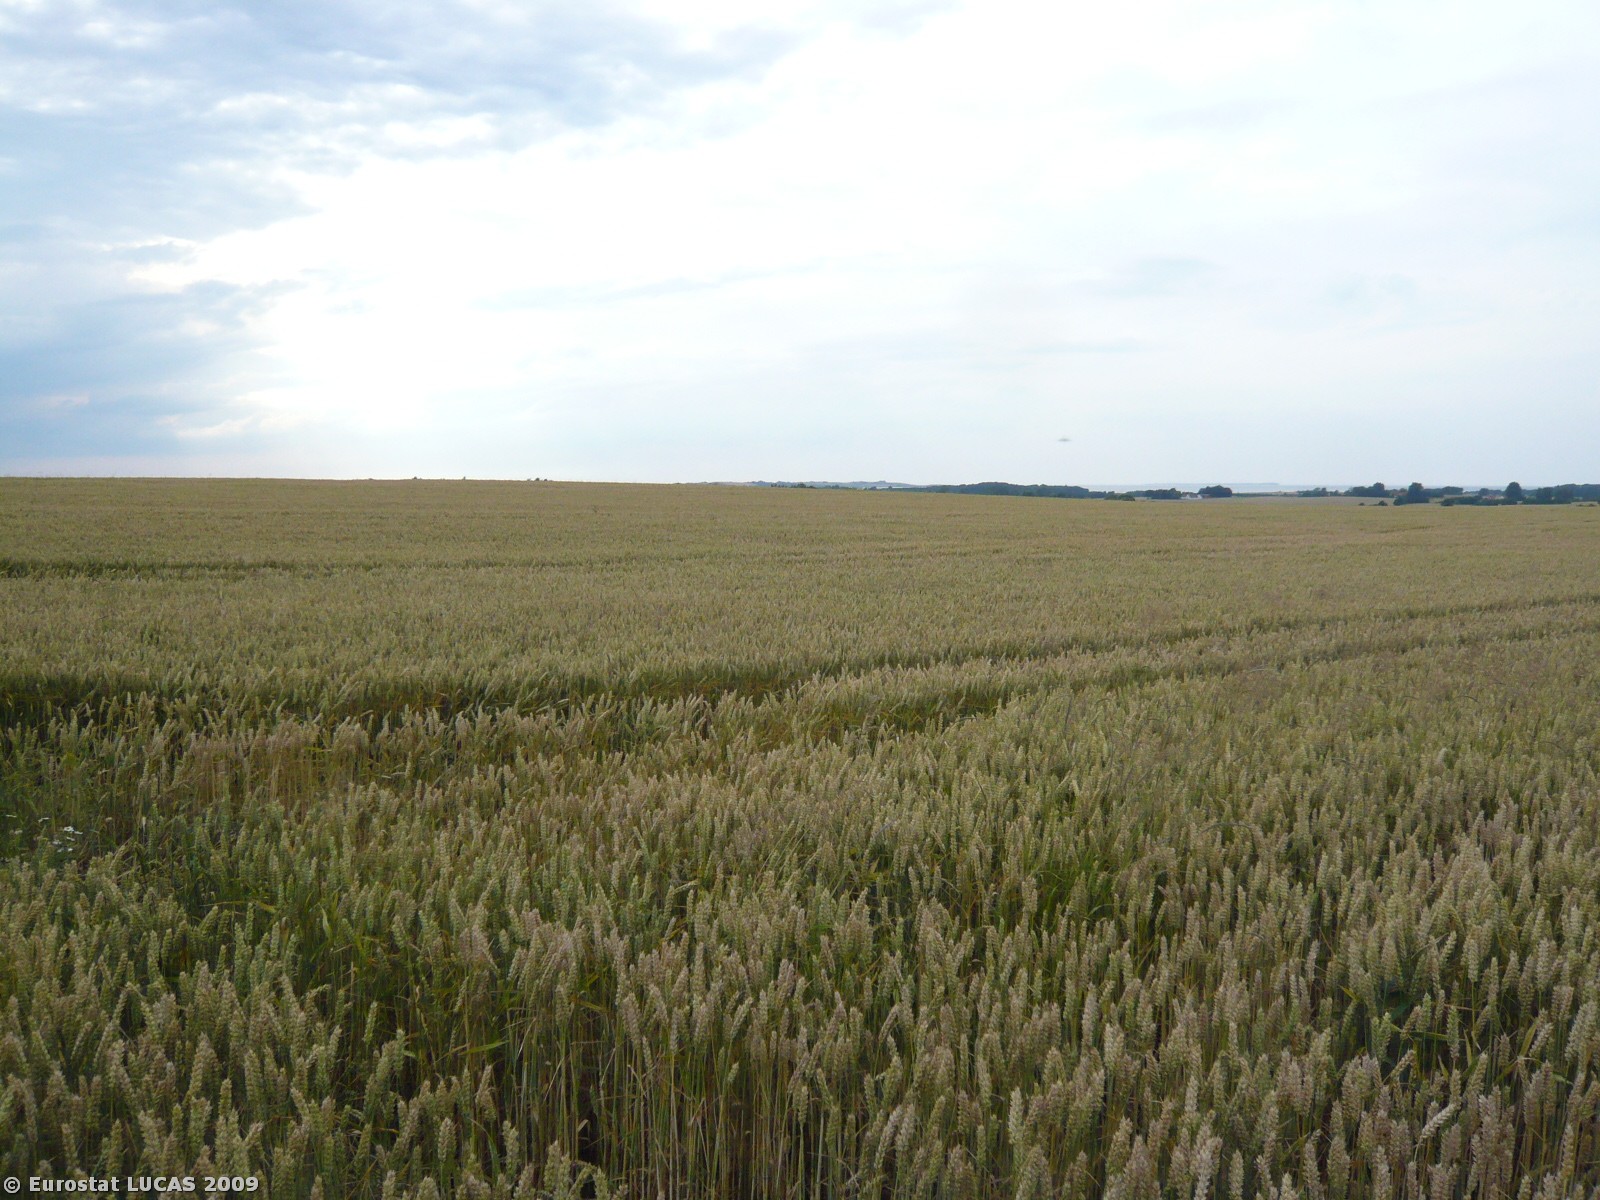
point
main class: Cropland
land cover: Common wheat
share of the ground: > 75 %
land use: Agriculture (excluding fallow land and kitchen gardens)
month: July
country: DK
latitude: 55.7485
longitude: 11.4165
